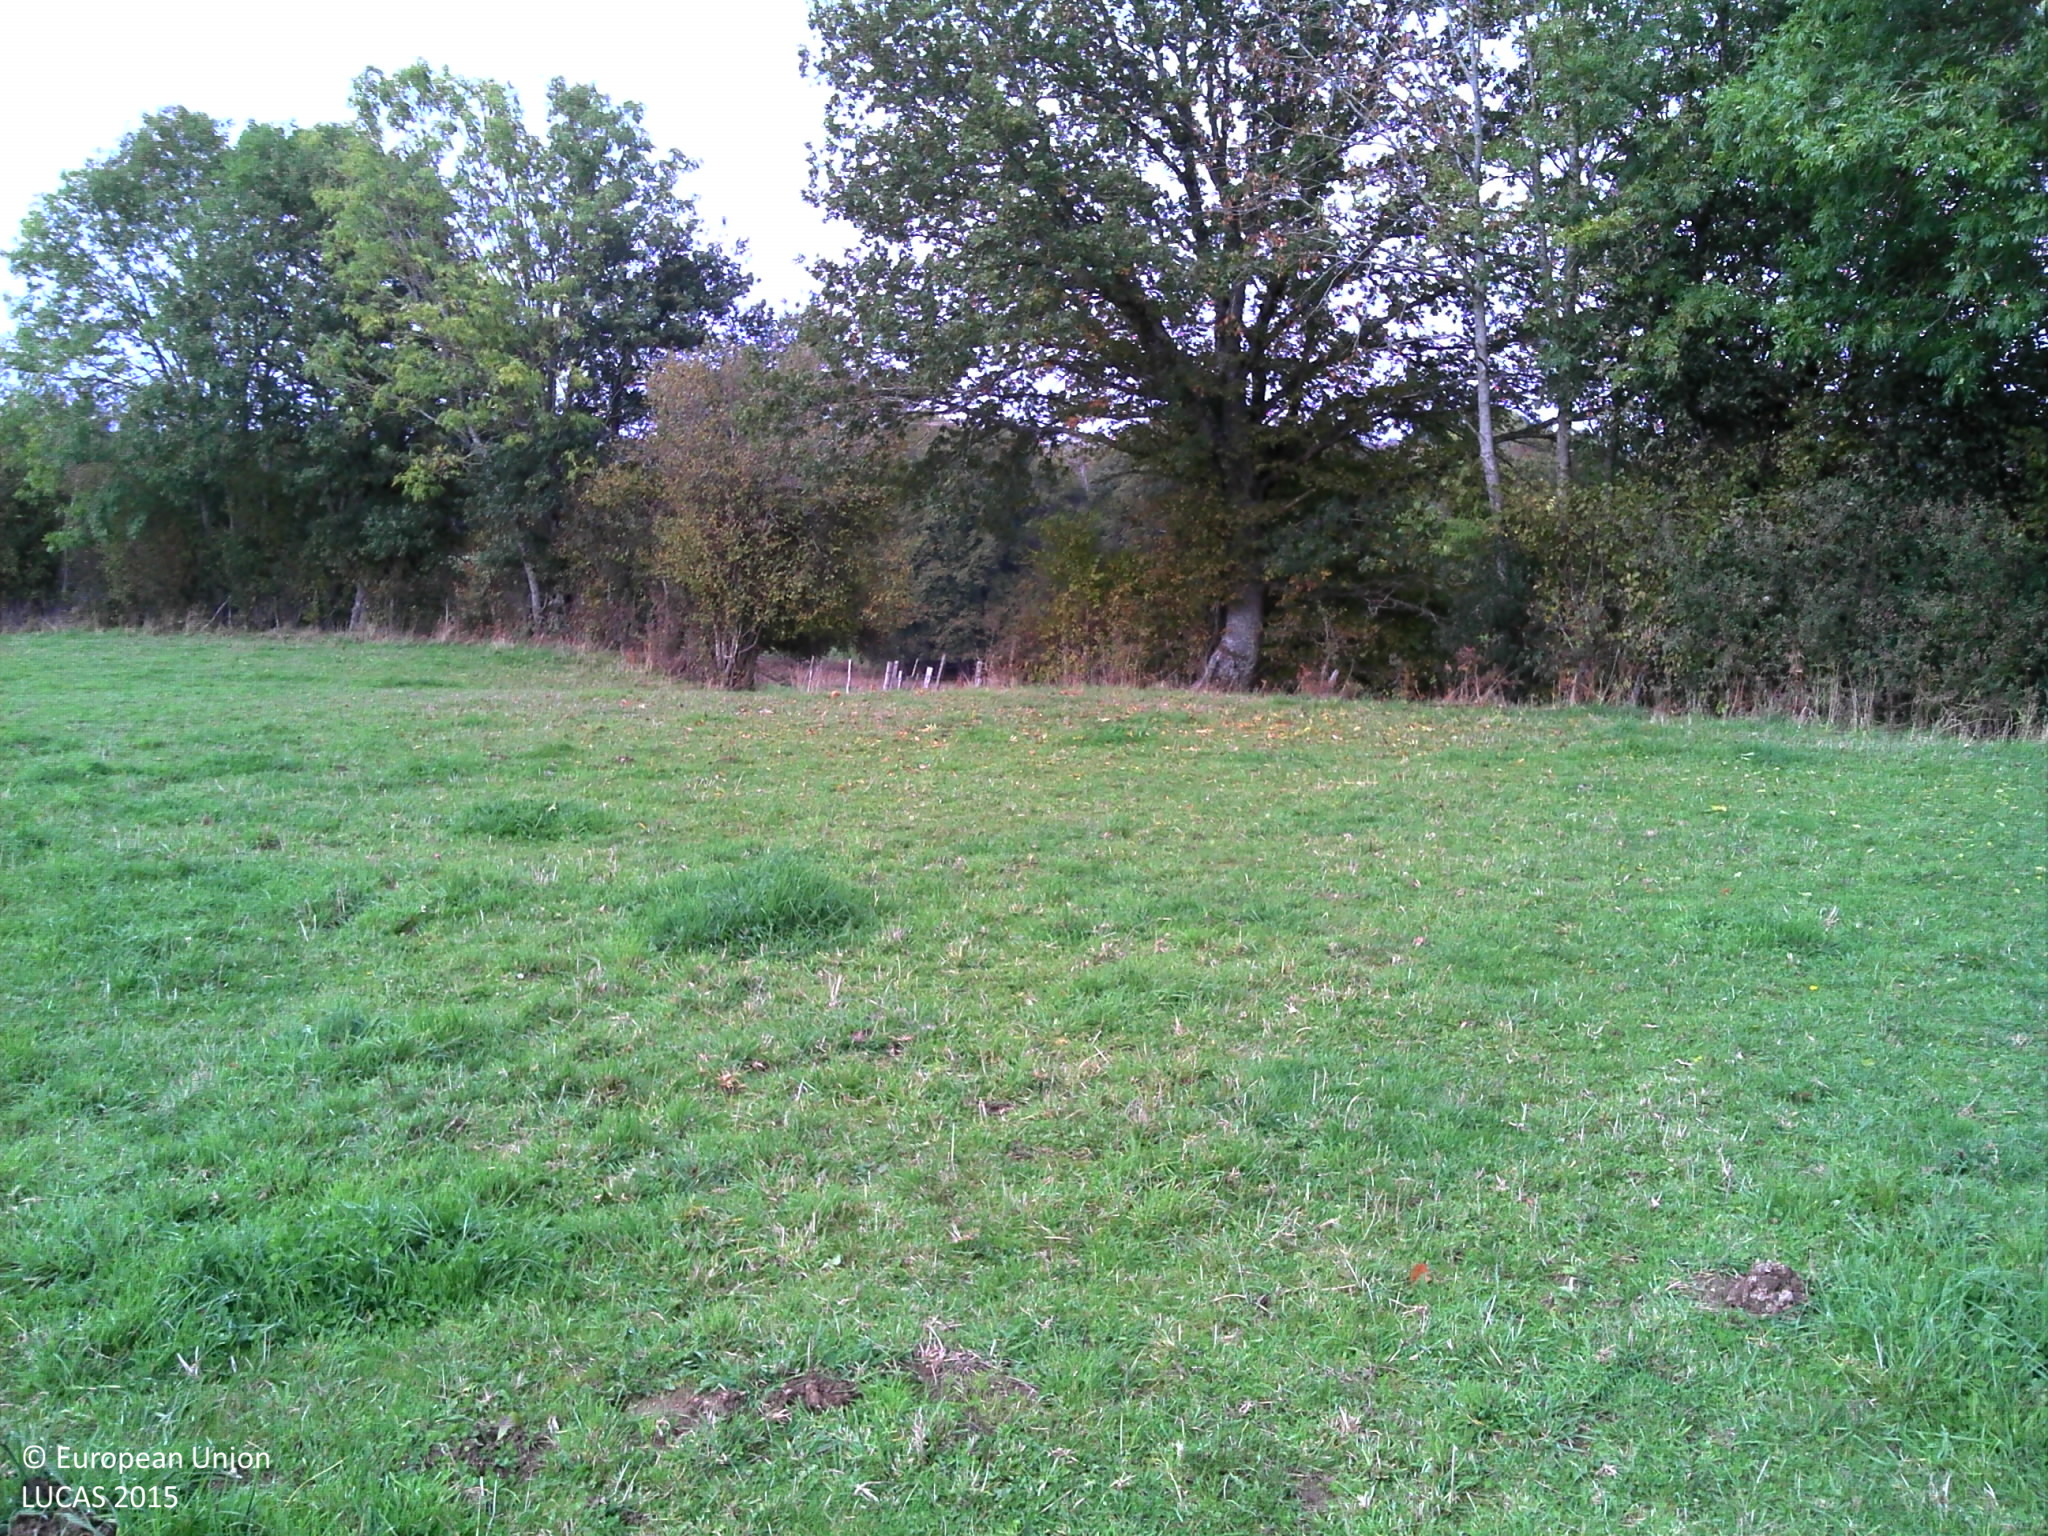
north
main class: Grassland
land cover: Grassland without tree/shrub cover
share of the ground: > 75 %
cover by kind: herbaceous plants 100 %
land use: Agriculture (excluding fallow land and kitchen gardens)
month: October
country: FR
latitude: 46.0737
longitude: 2.8218
